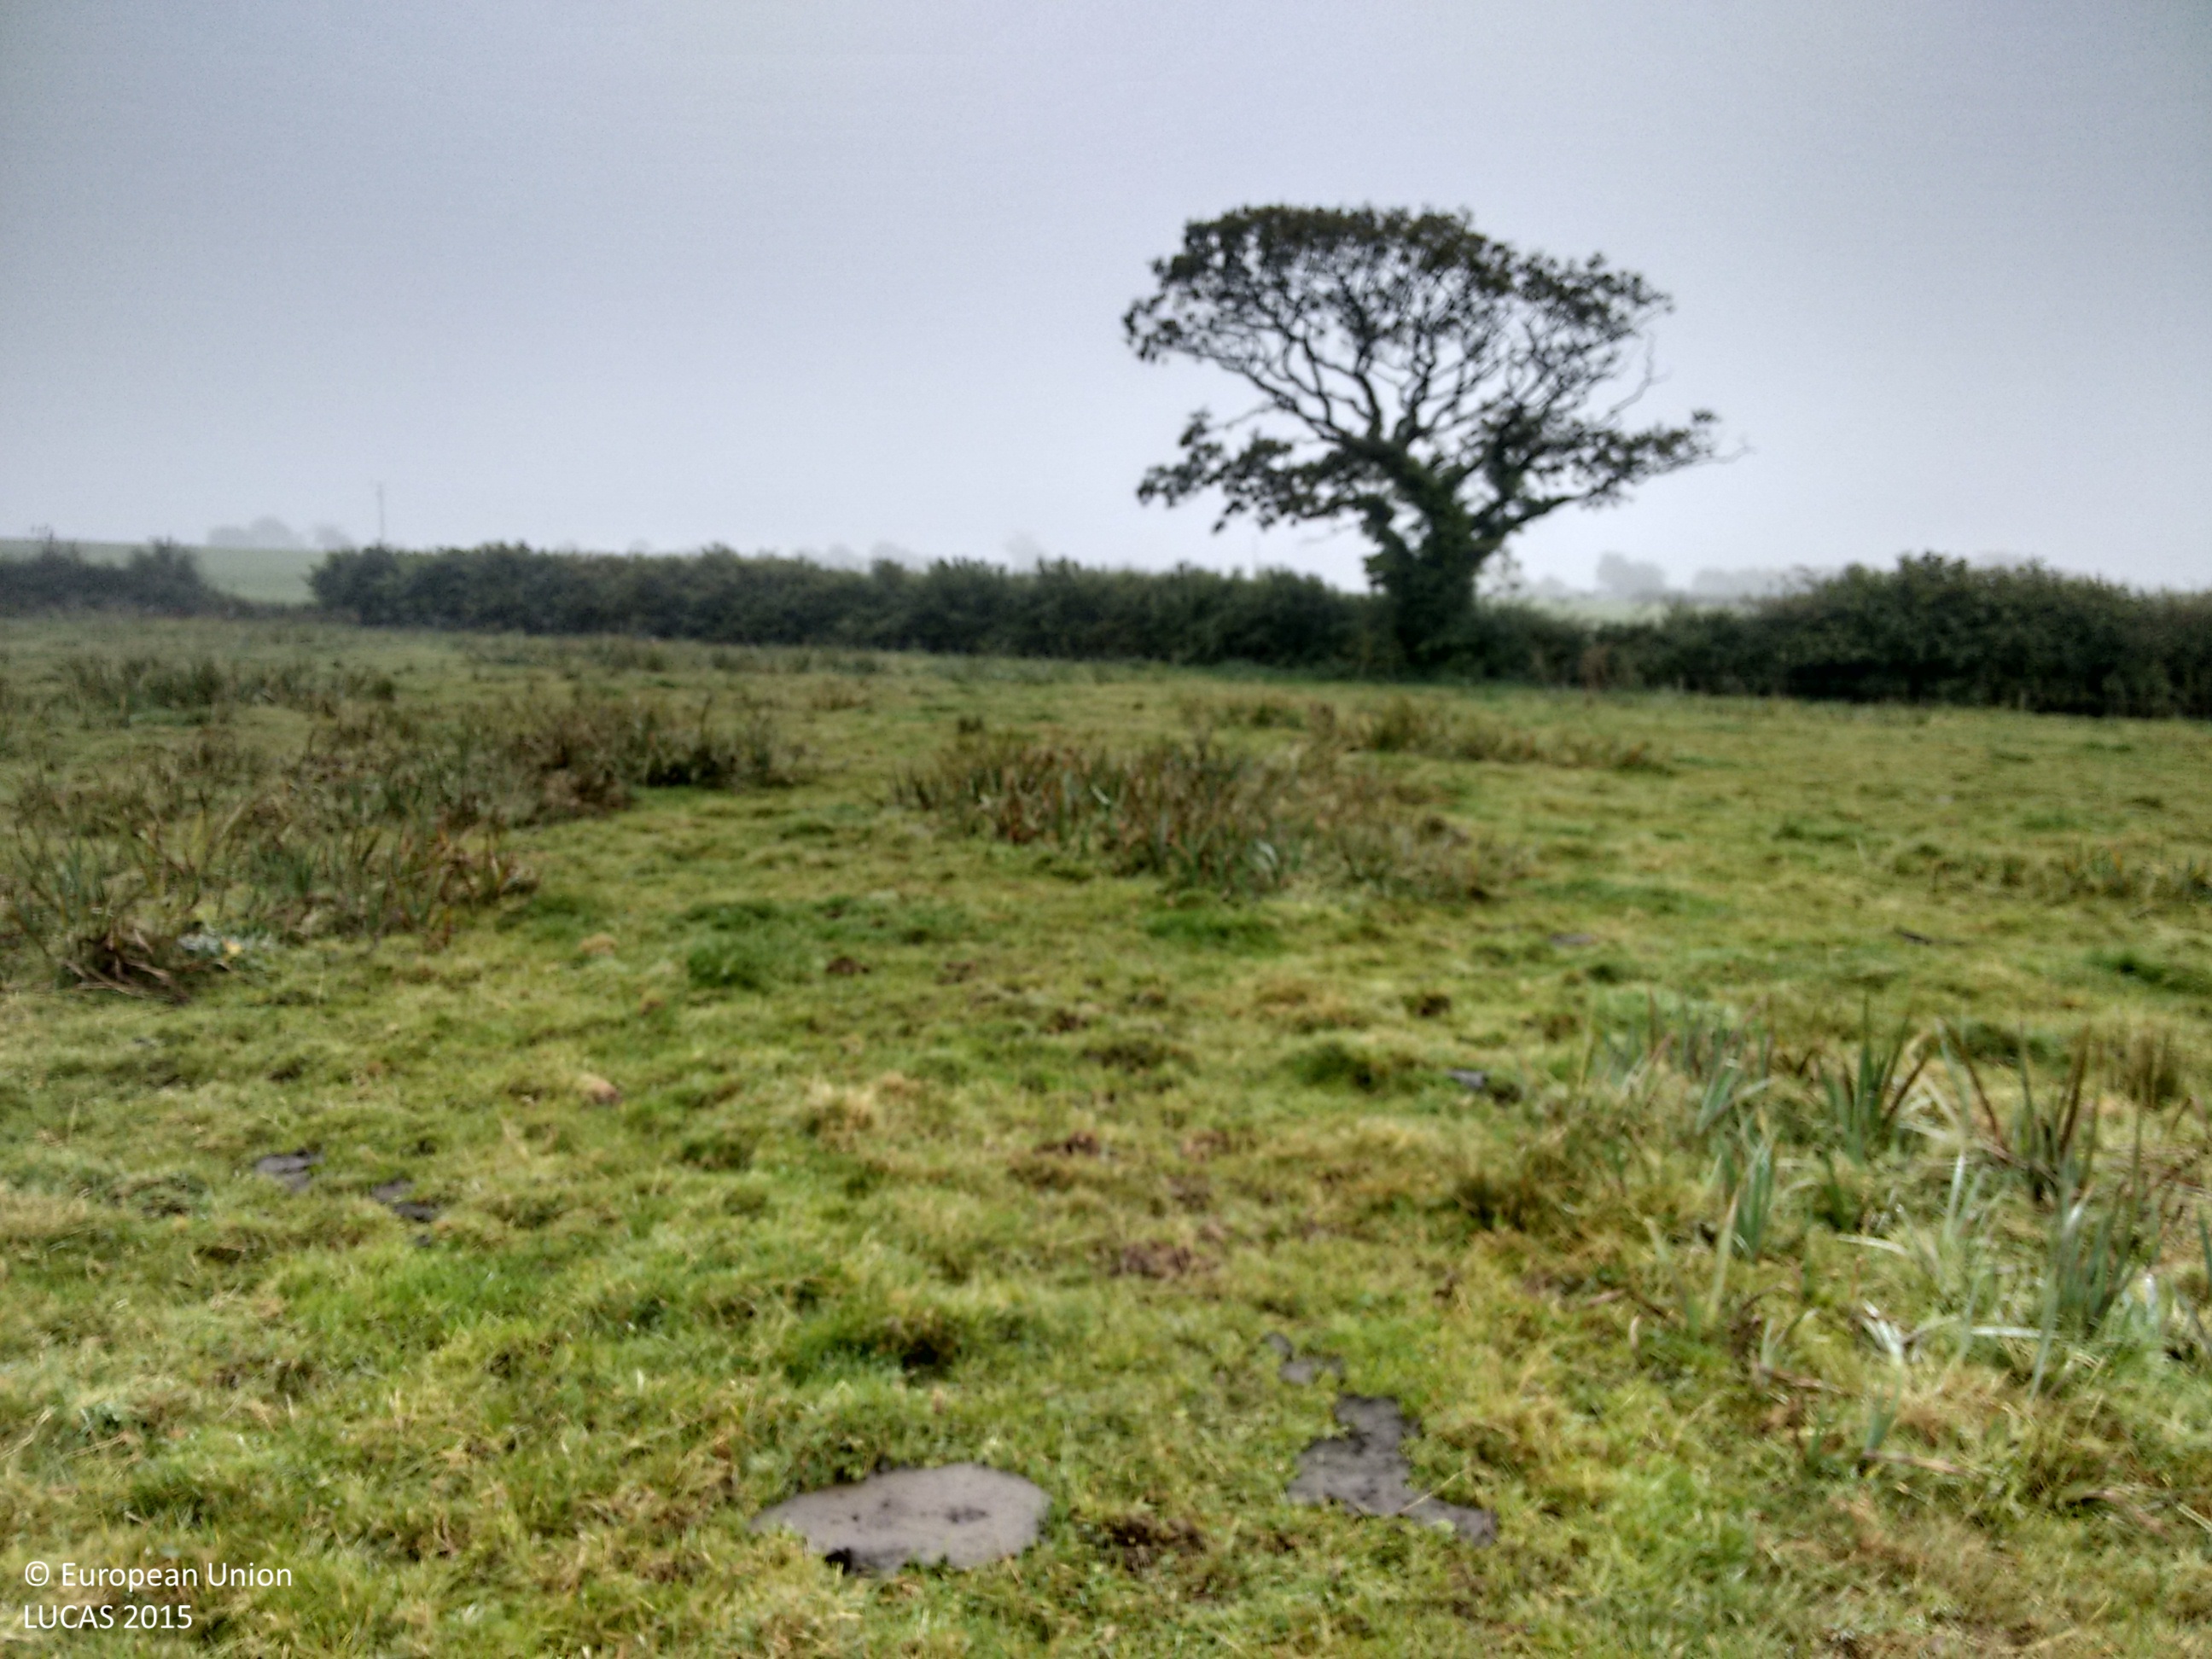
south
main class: Grassland
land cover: Grassland without tree/shrub cover
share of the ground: > 75 %
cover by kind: herbaceous plants 100 %
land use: Agriculture (excluding fallow land and kitchen gardens)
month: October
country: IE
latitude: 52.4667
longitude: -9.0105
